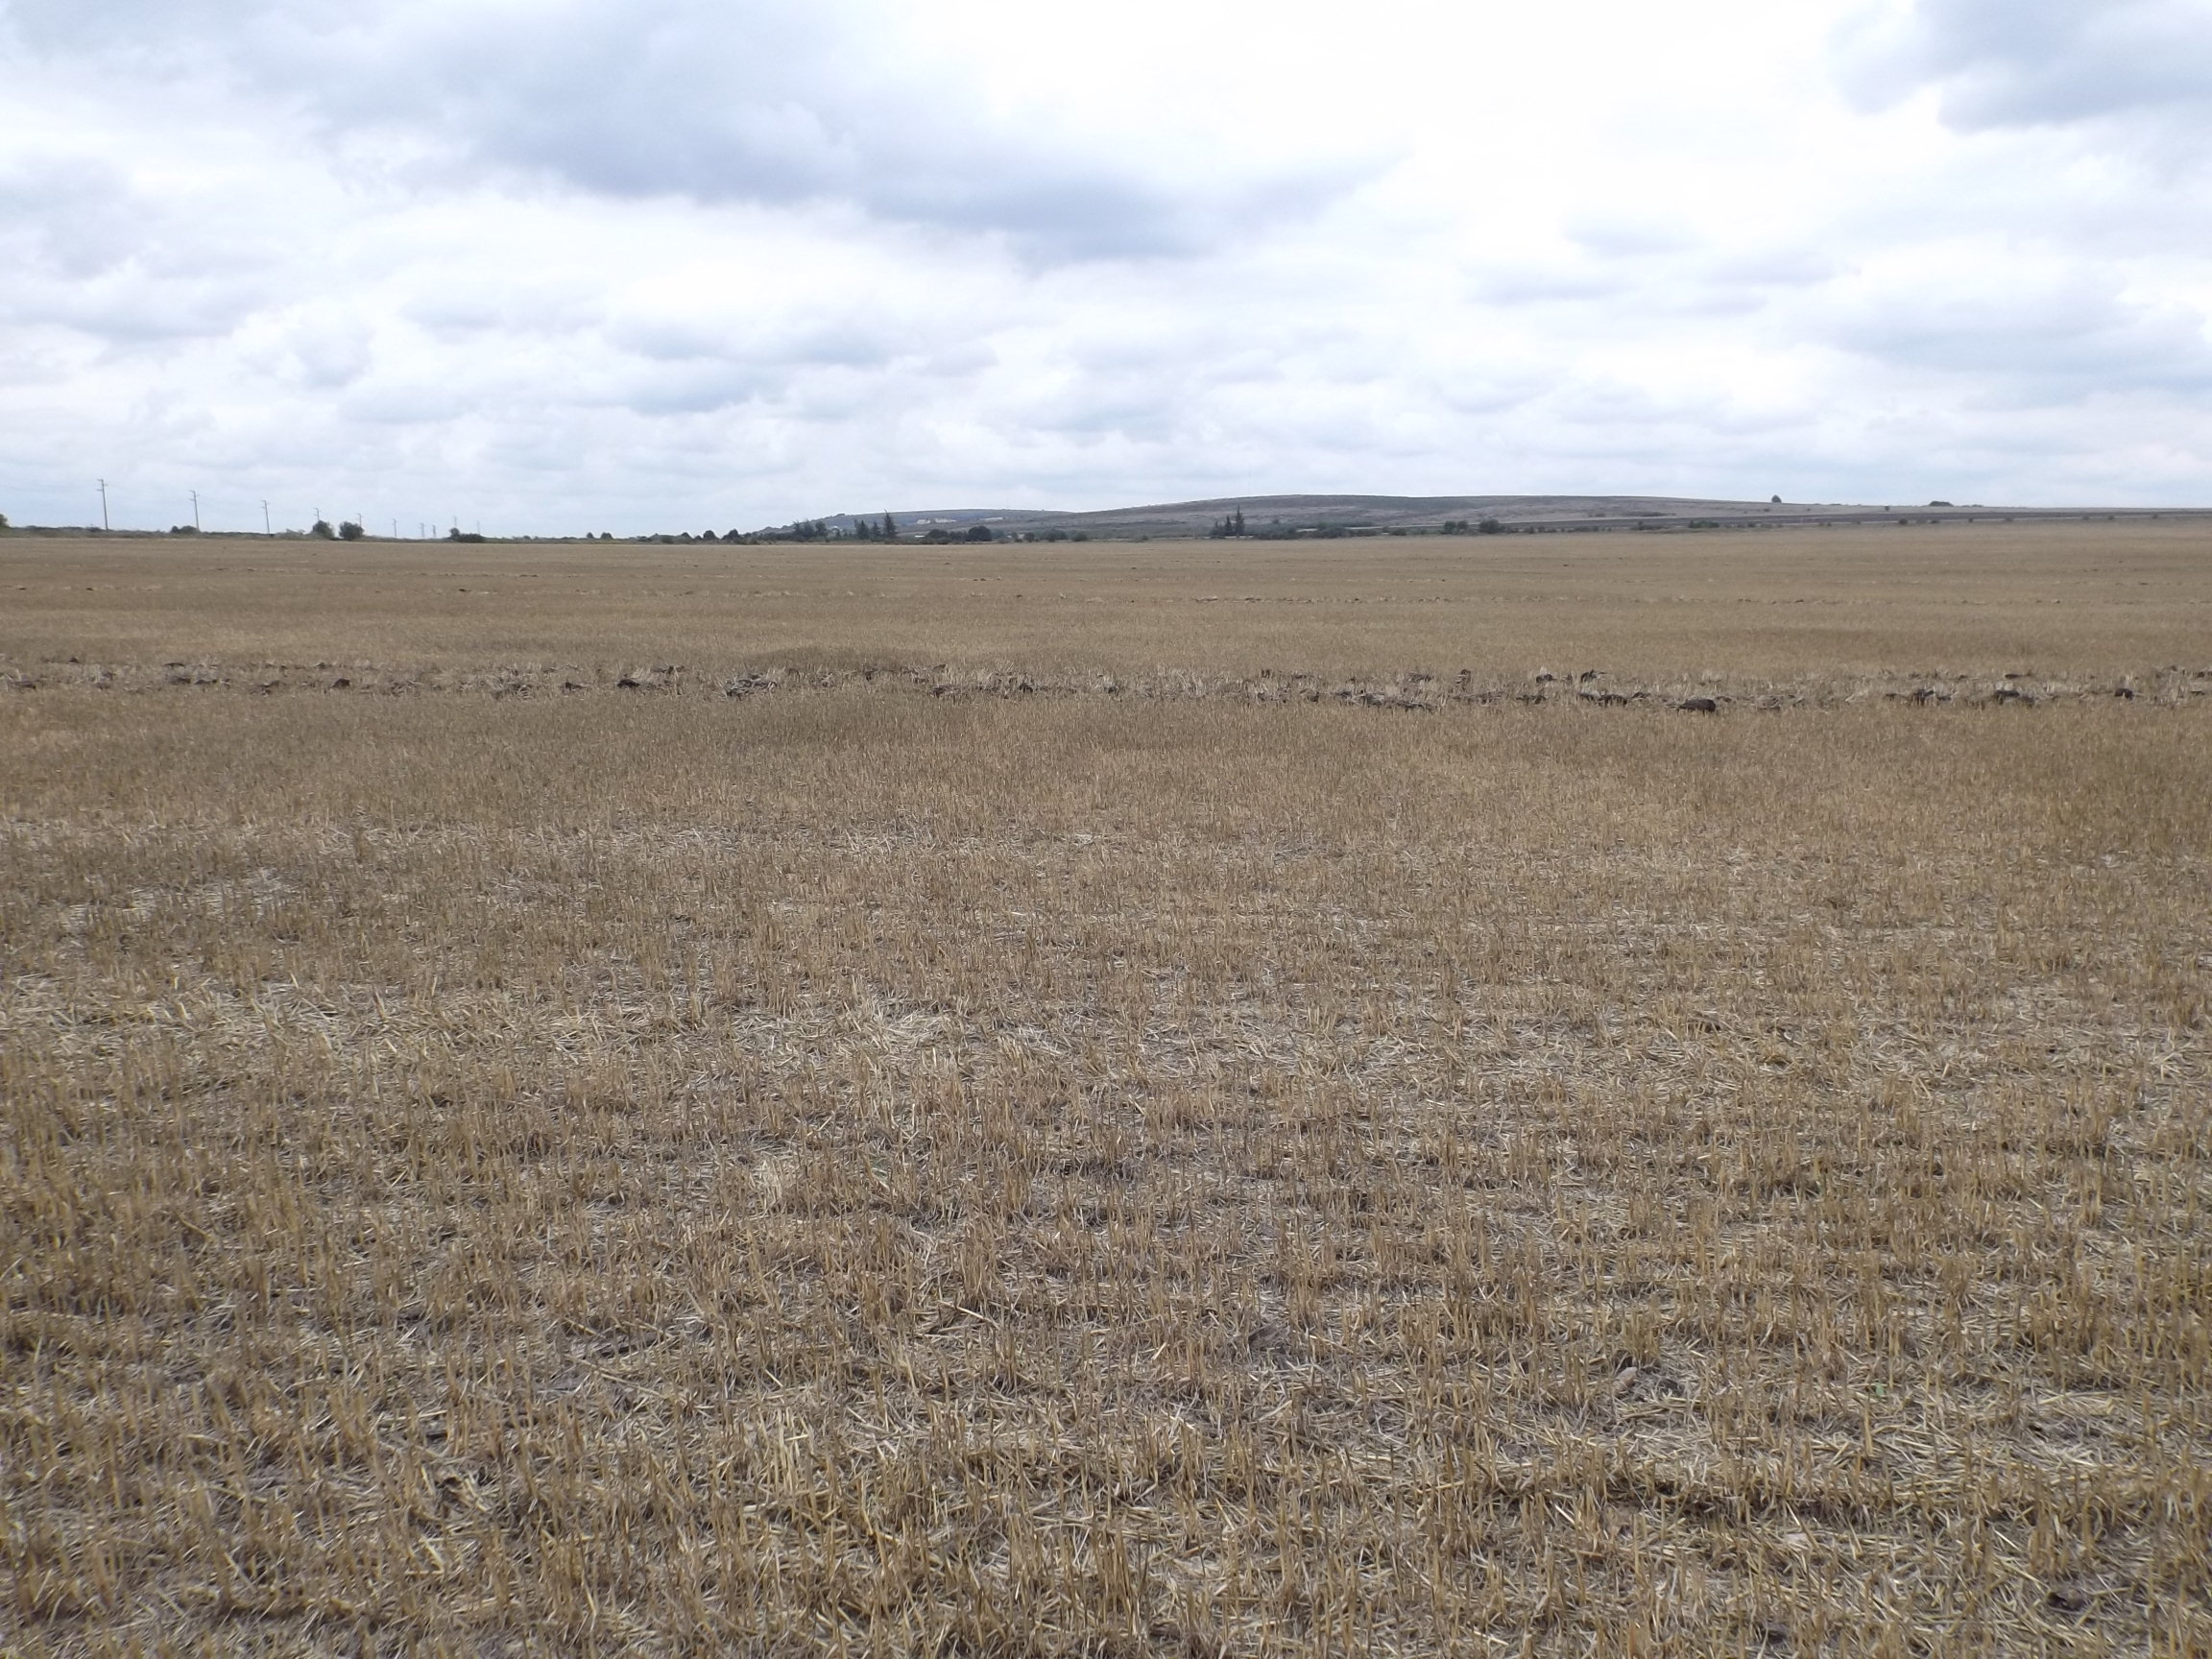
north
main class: Cropland
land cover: Common wheat
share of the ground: < 10 %
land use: Agriculture (excluding fallow land and kitchen gardens)
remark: Harvested field
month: August
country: BG
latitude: 43.2482
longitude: 27.4305
